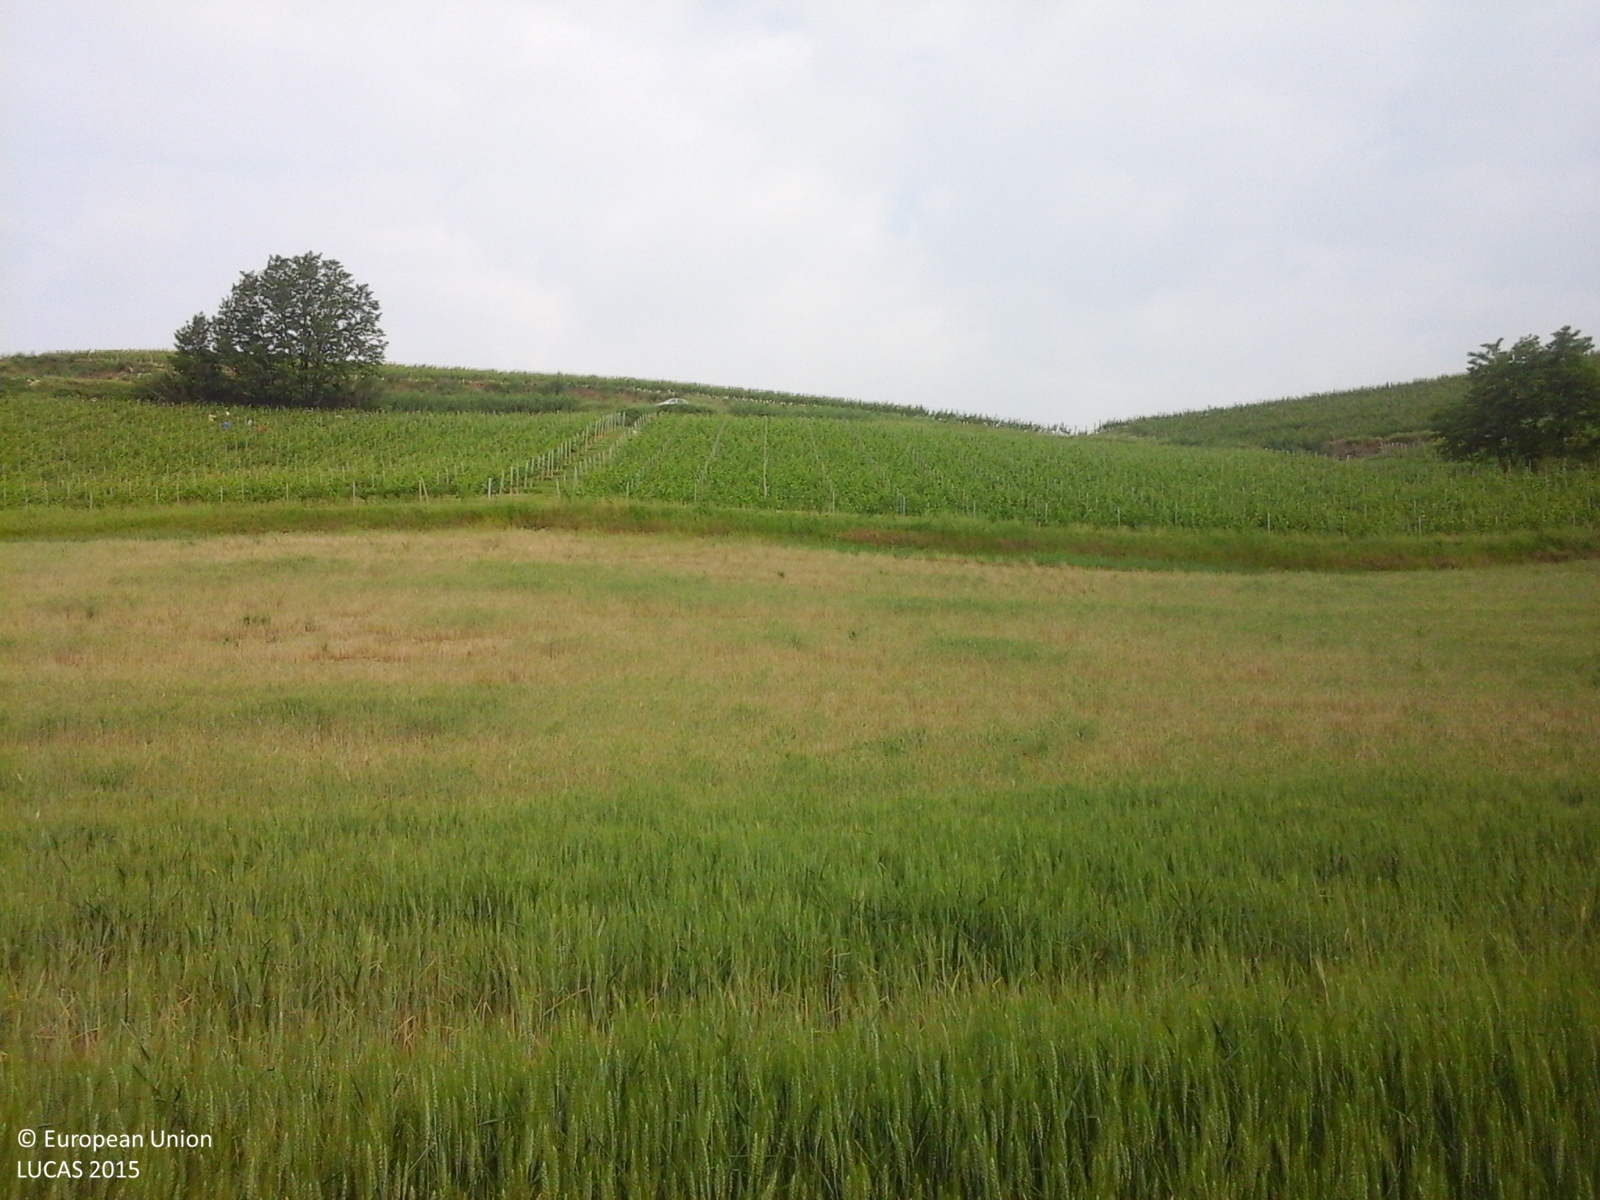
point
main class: Cropland
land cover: Common wheat
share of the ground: > 75 %
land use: Agriculture (excluding fallow land and kitchen gardens)
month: May
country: IT
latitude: 44.8205
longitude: 8.1193
